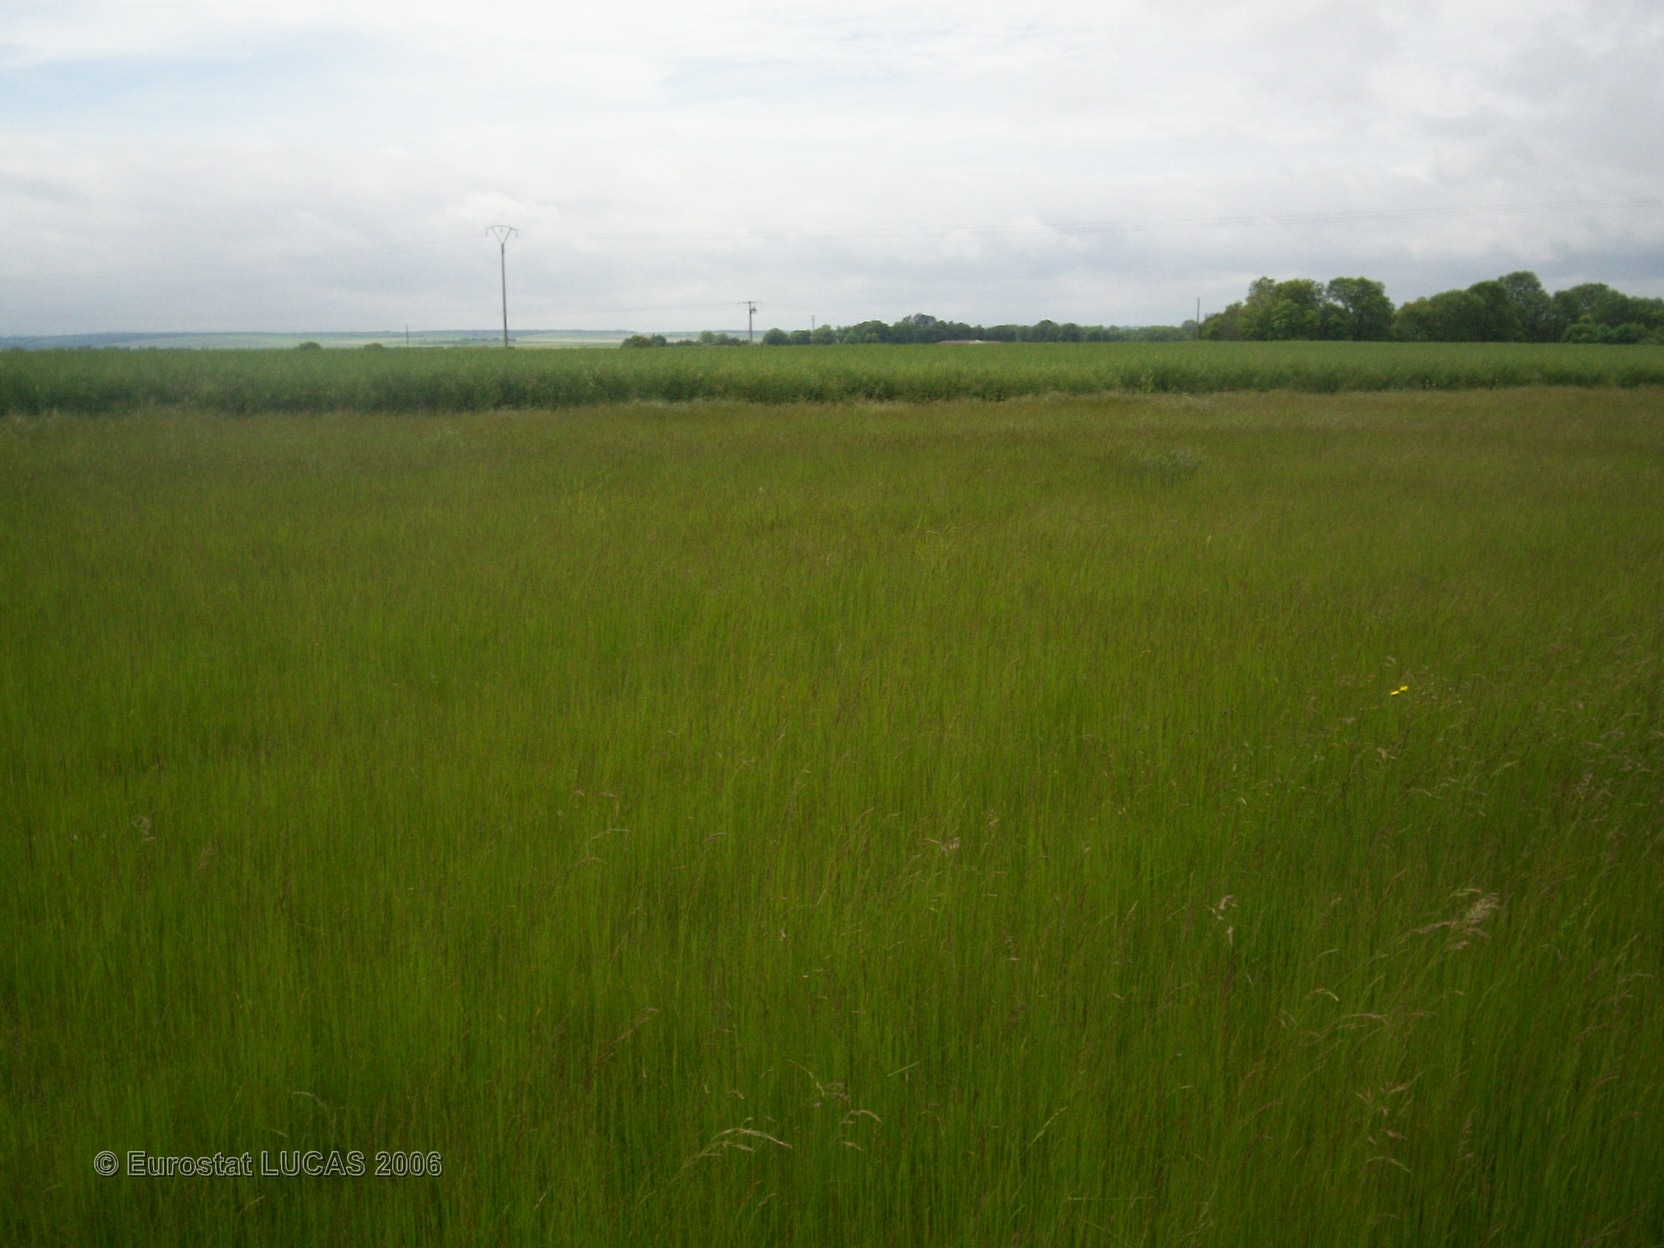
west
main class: Grassland
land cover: Grassland without tree/shrub cover
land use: Agriculture (excluding fallow land and kitchen gardens)
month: May
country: FR
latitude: 48.3663
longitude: 3.9892
